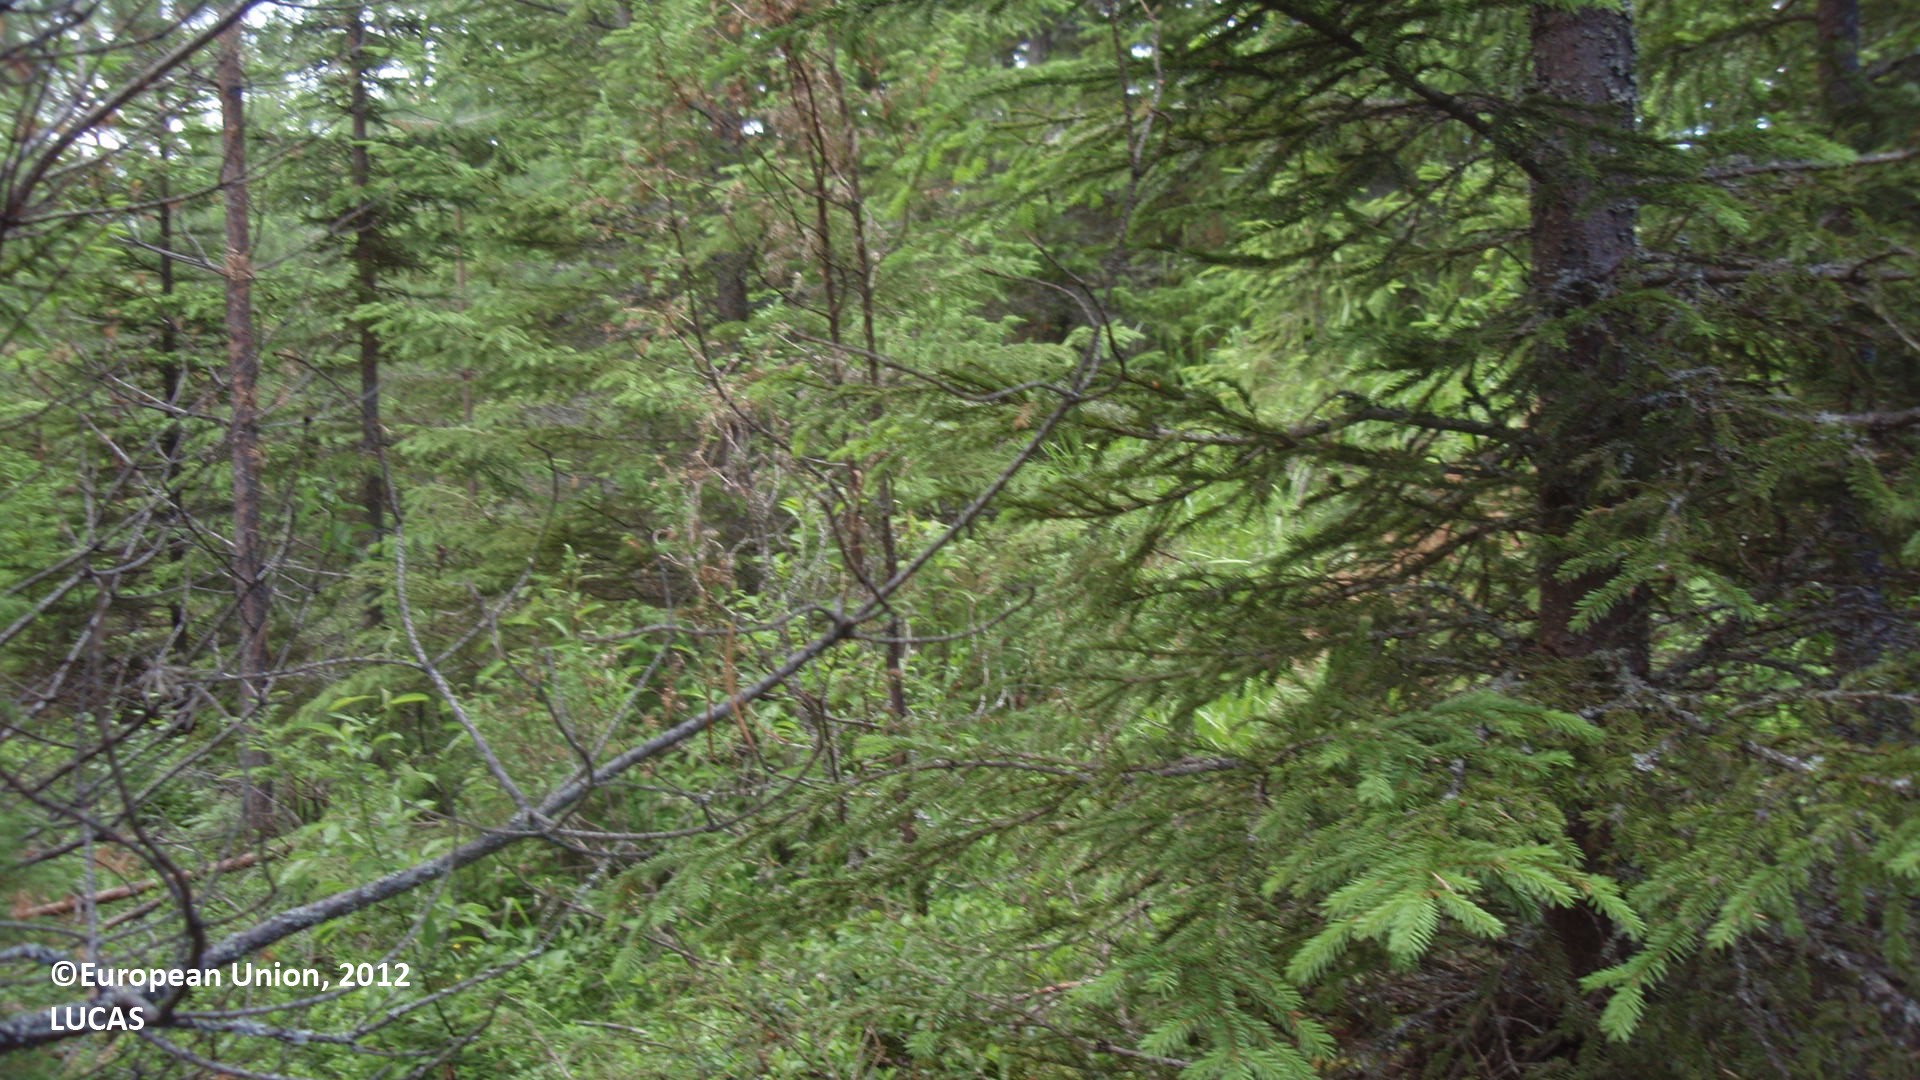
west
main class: Woodland
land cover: Spruce dominated coniferous woodland
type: boreal forest
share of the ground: 50 - 75 %
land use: Forestry
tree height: < 5 m
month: July
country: FI
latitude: 61.6692
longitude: 28.0836
